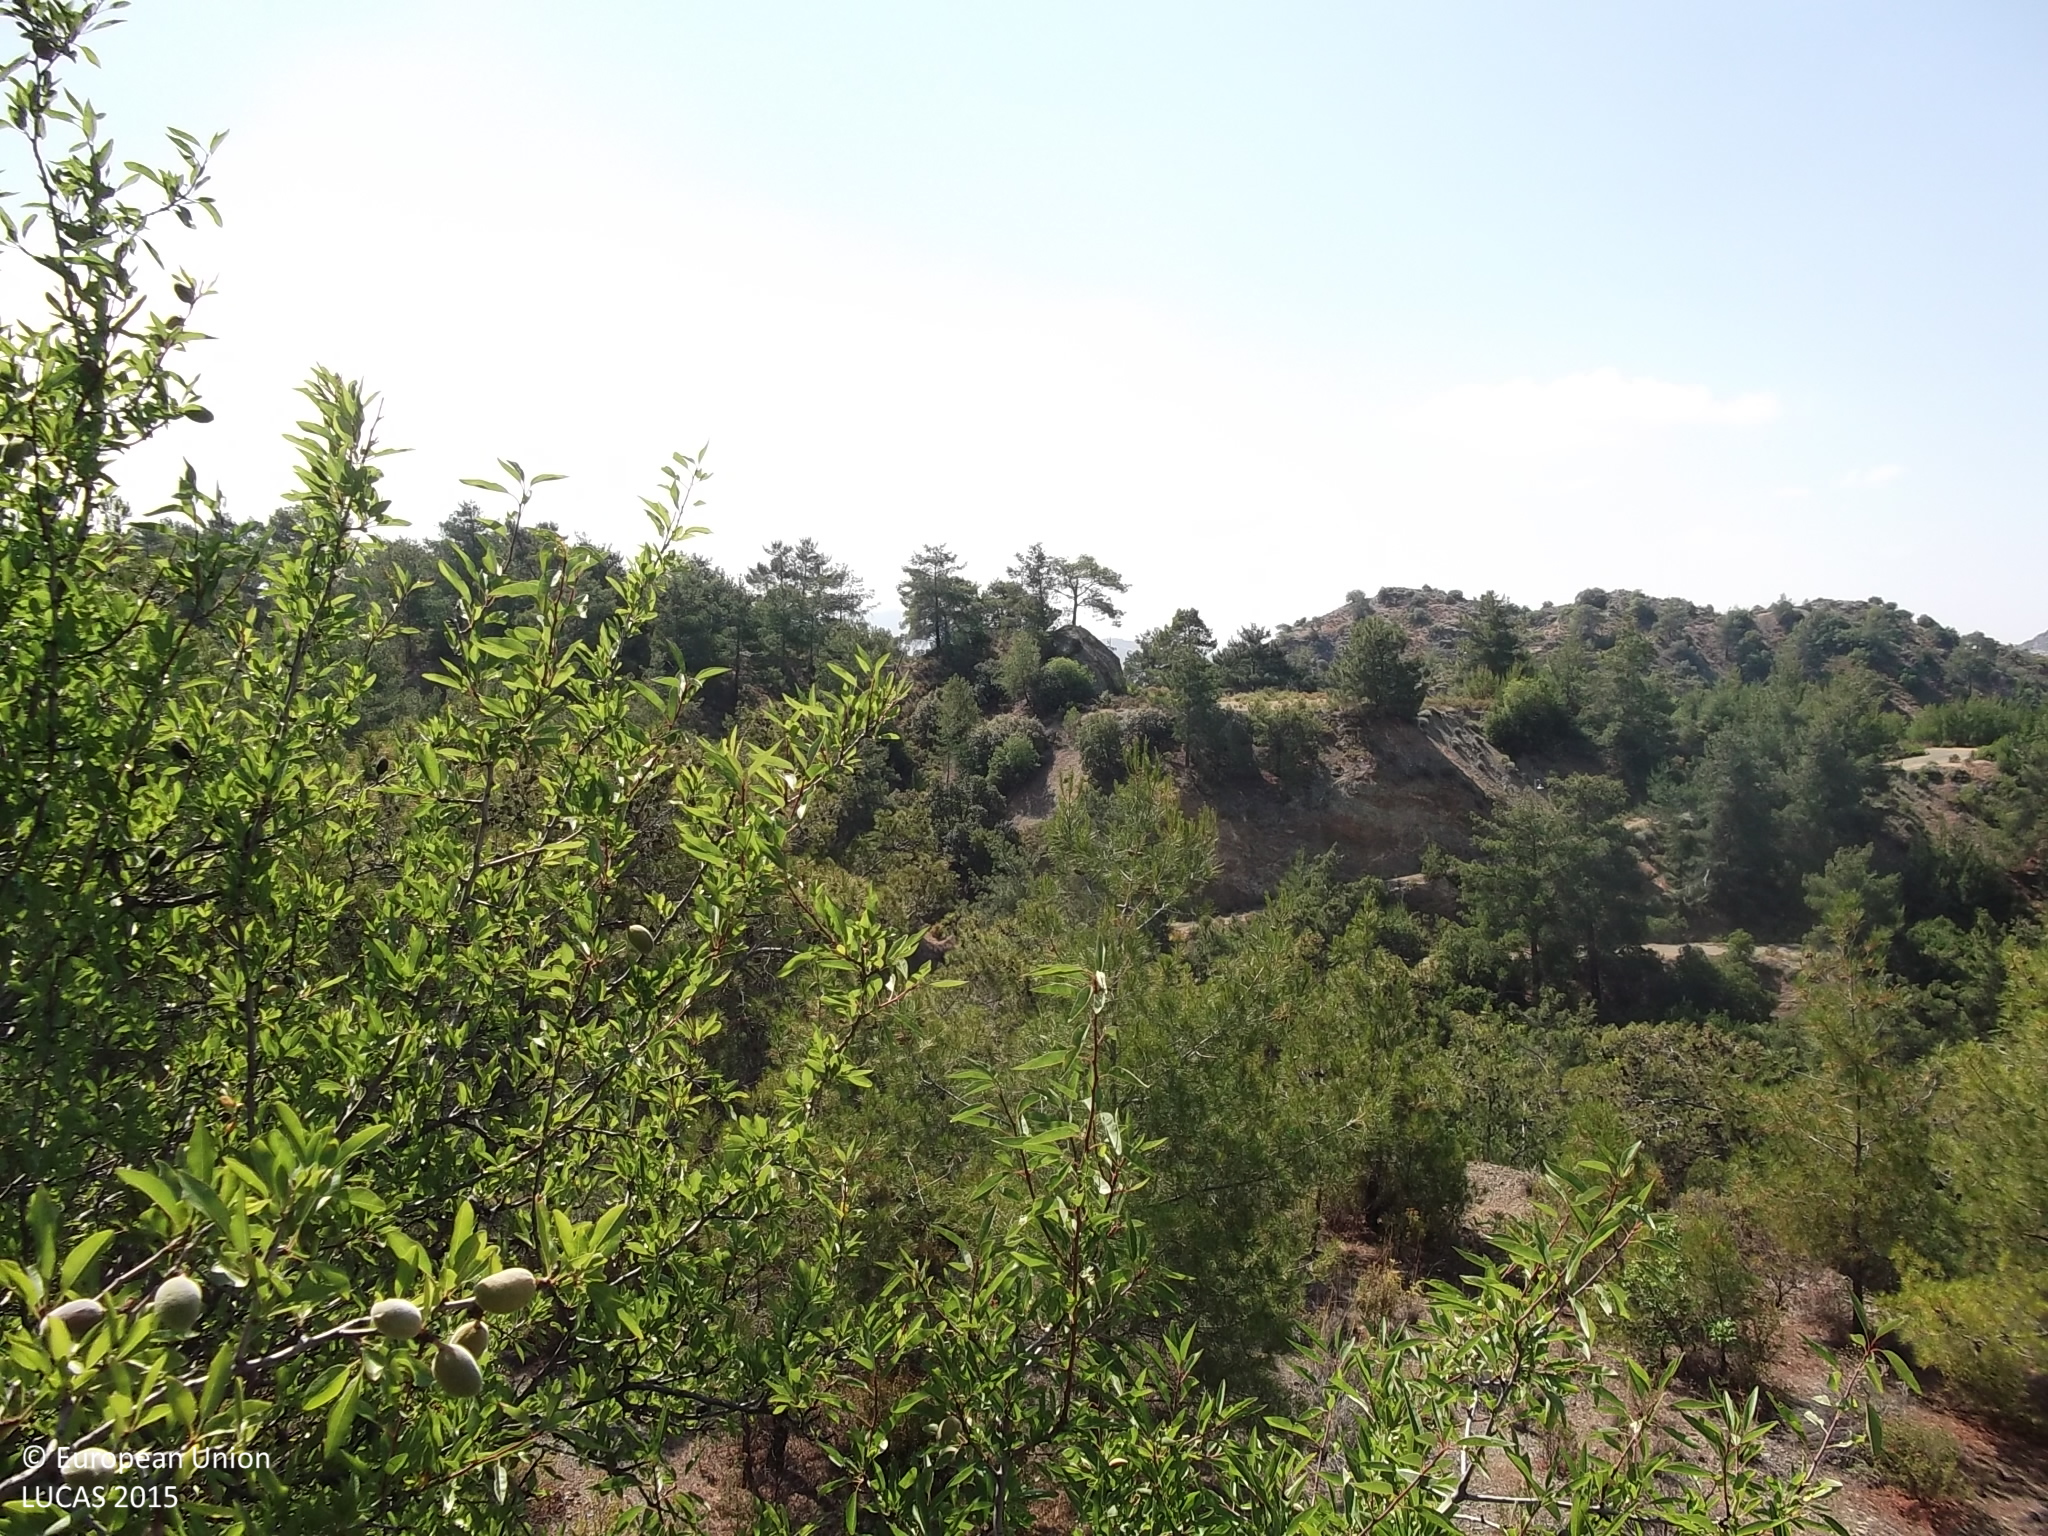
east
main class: Shrubland
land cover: Shrubland with sparse tree cover
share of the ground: > 75 %
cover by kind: shrubs 95 %, broadleaved forest trees 5 %
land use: Semi-natural and natural areas not in use
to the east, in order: Shrubland with sparse tree cover; Pine dominated coniferous woodland; Tracks; Pine dominated coniferous woodland
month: June
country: CY
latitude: 34.8678
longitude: 32.9312
